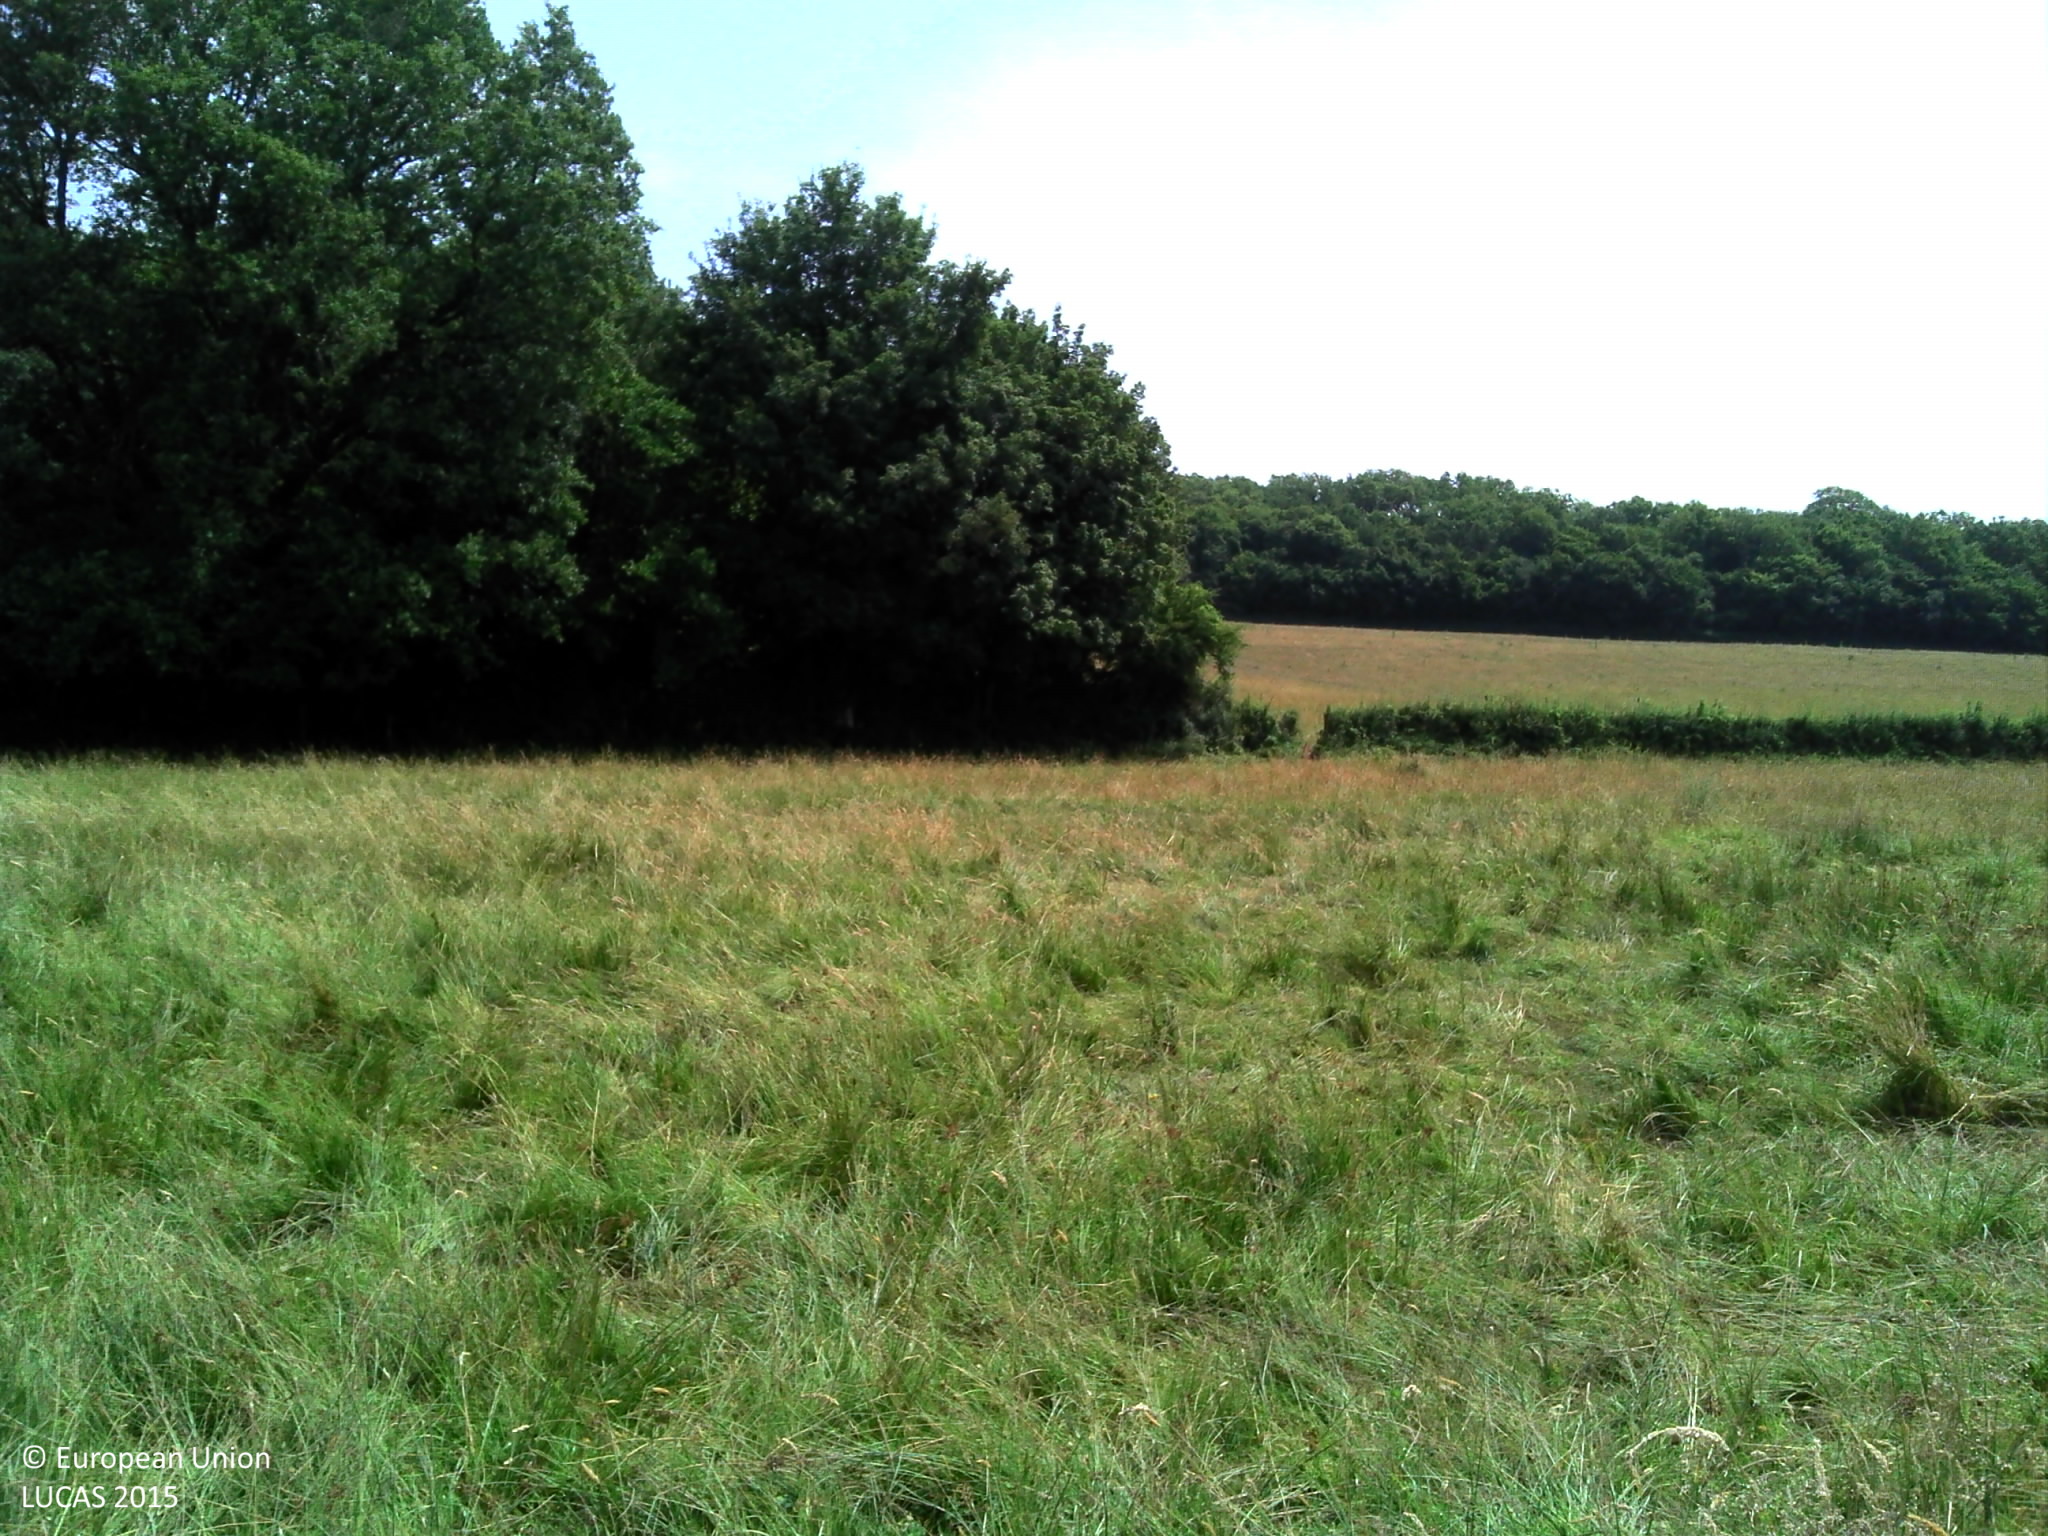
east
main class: Grassland
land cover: Grassland without tree/shrub cover
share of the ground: > 75 %
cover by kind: herbaceous plants 100 %
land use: Agriculture (excluding fallow land and kitchen gardens)
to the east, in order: Grassland without tree/shrub cover; Fences; Managed hedges; Grassland without tree/shrub cover; Fences; Broadleaved woodland
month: July
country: FR
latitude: 47.0766
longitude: 3.5310
